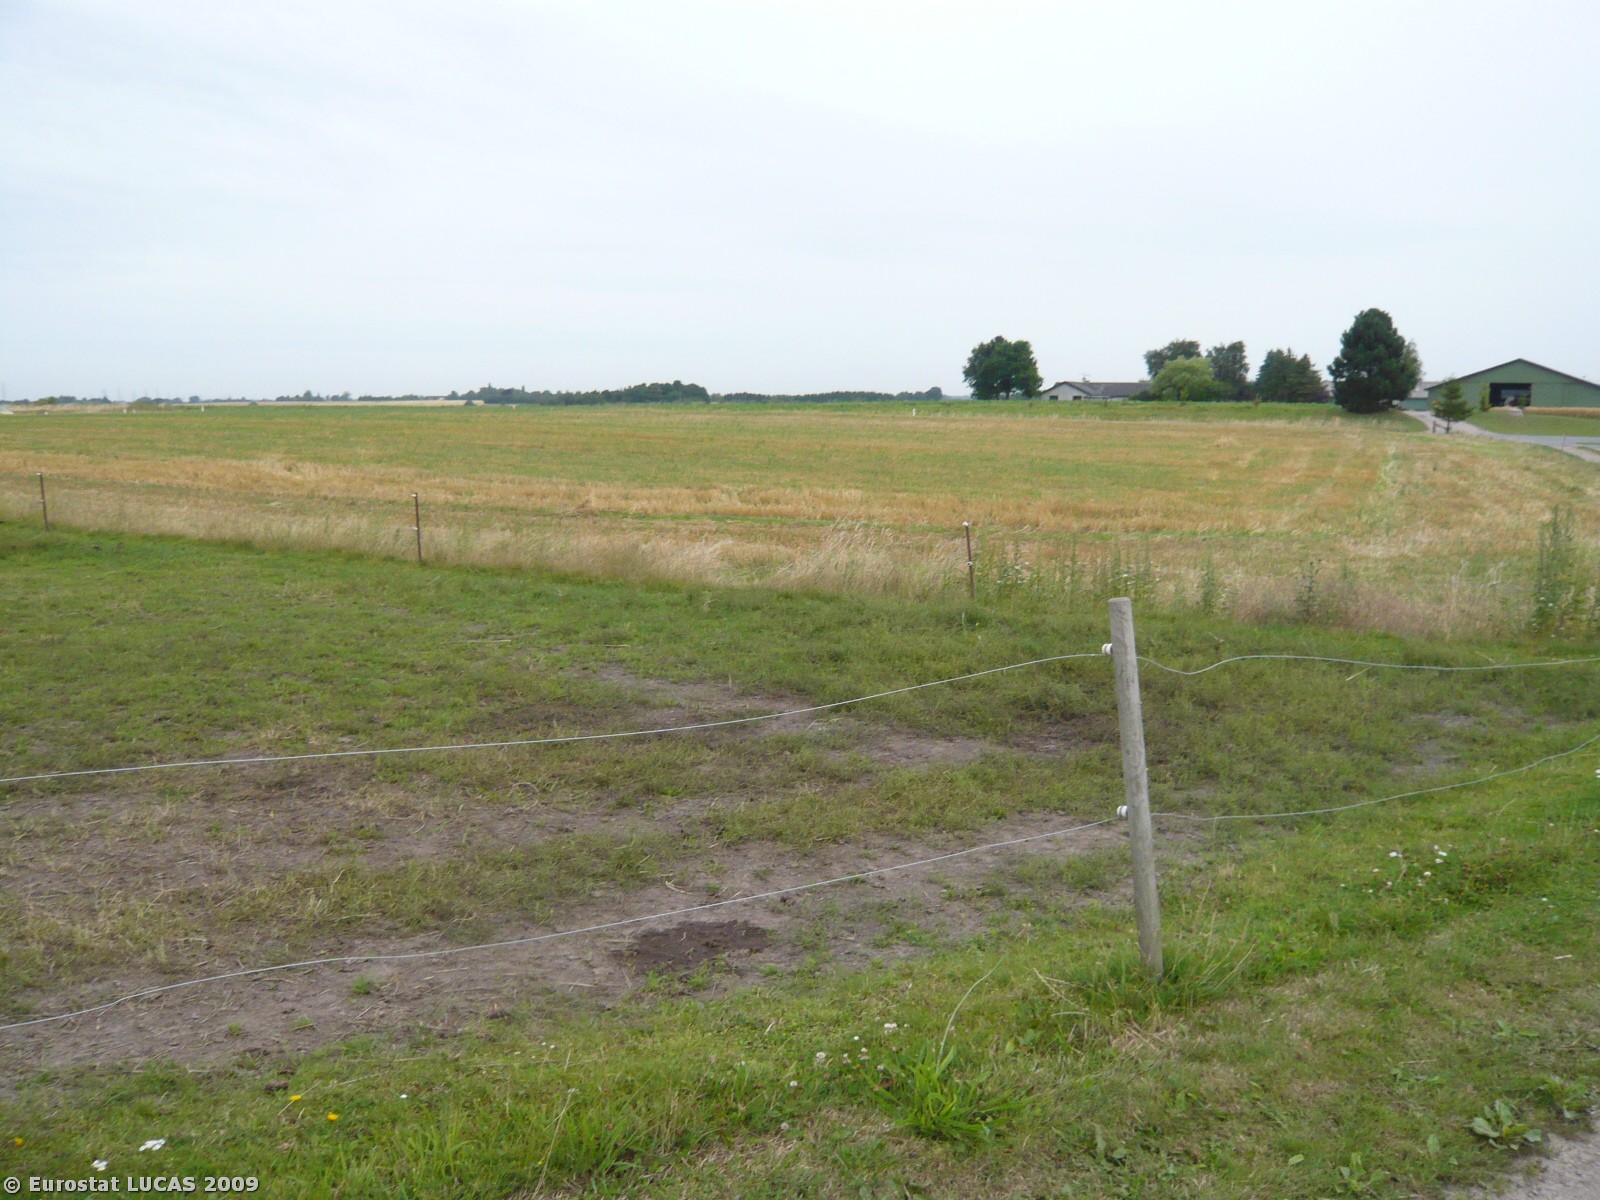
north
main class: Cropland
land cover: Common wheat
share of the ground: > 75 %
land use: Agriculture (excluding fallow land and kitchen gardens)
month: July
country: DK
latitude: 55.7545
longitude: 12.2447
